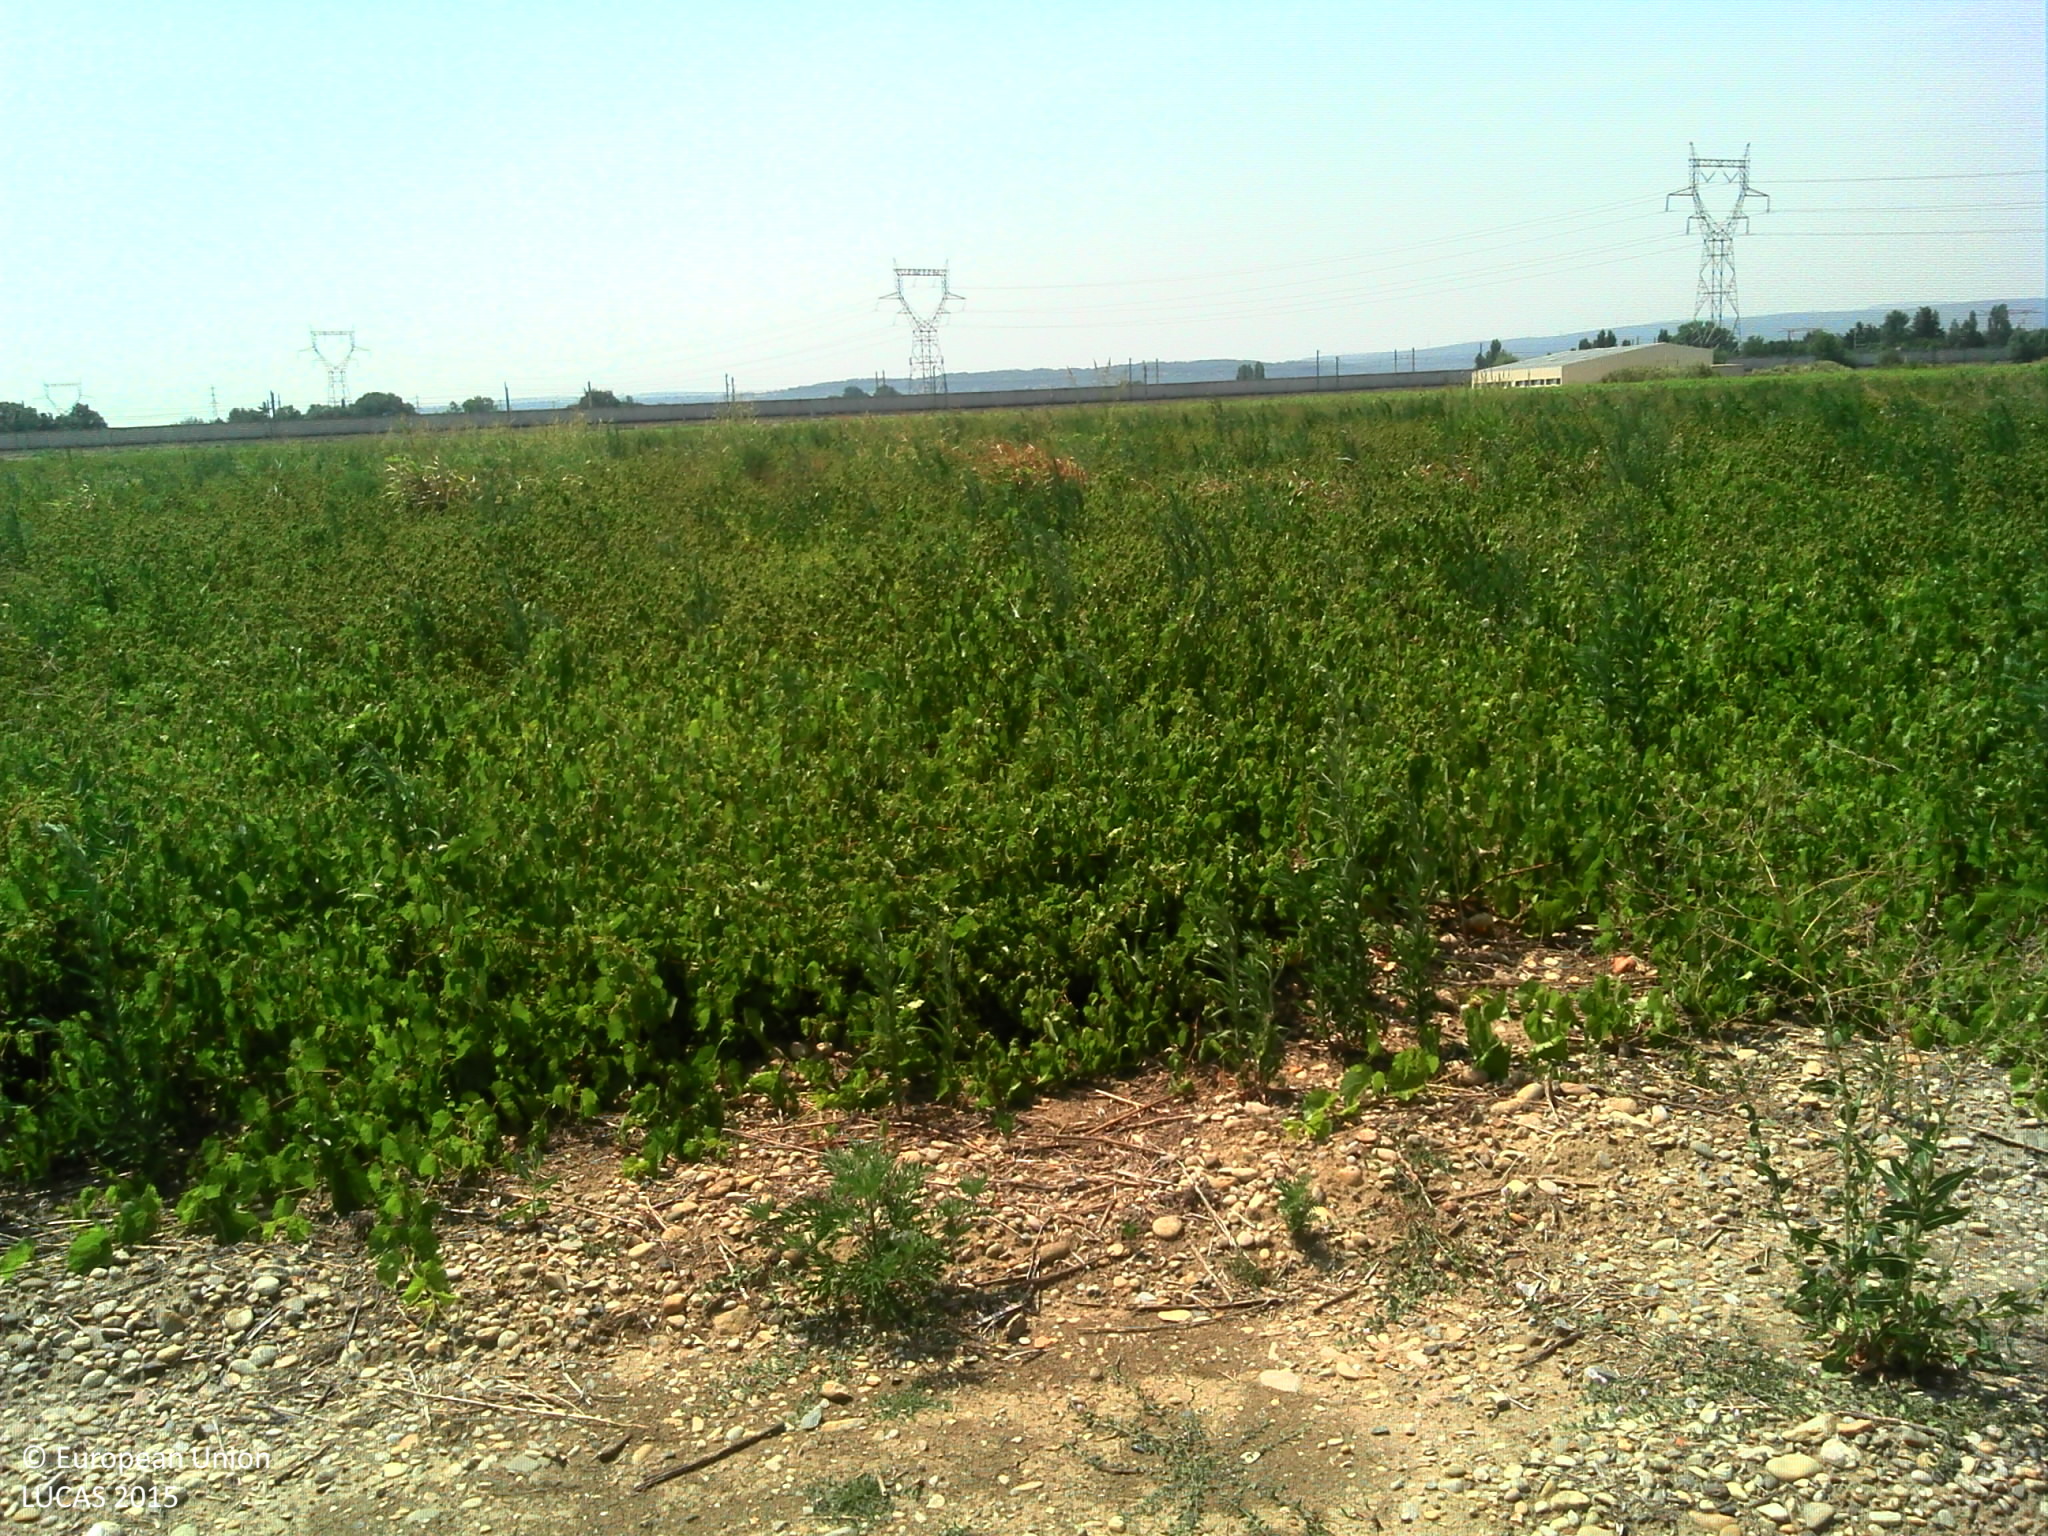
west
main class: Grassland
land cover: Spontaneously vegetated surfaces
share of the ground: > 75 %
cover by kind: herbaceous plants 100 %
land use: Semi-natural and natural areas not in use
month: July
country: FR
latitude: 44.3237
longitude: 4.7033
